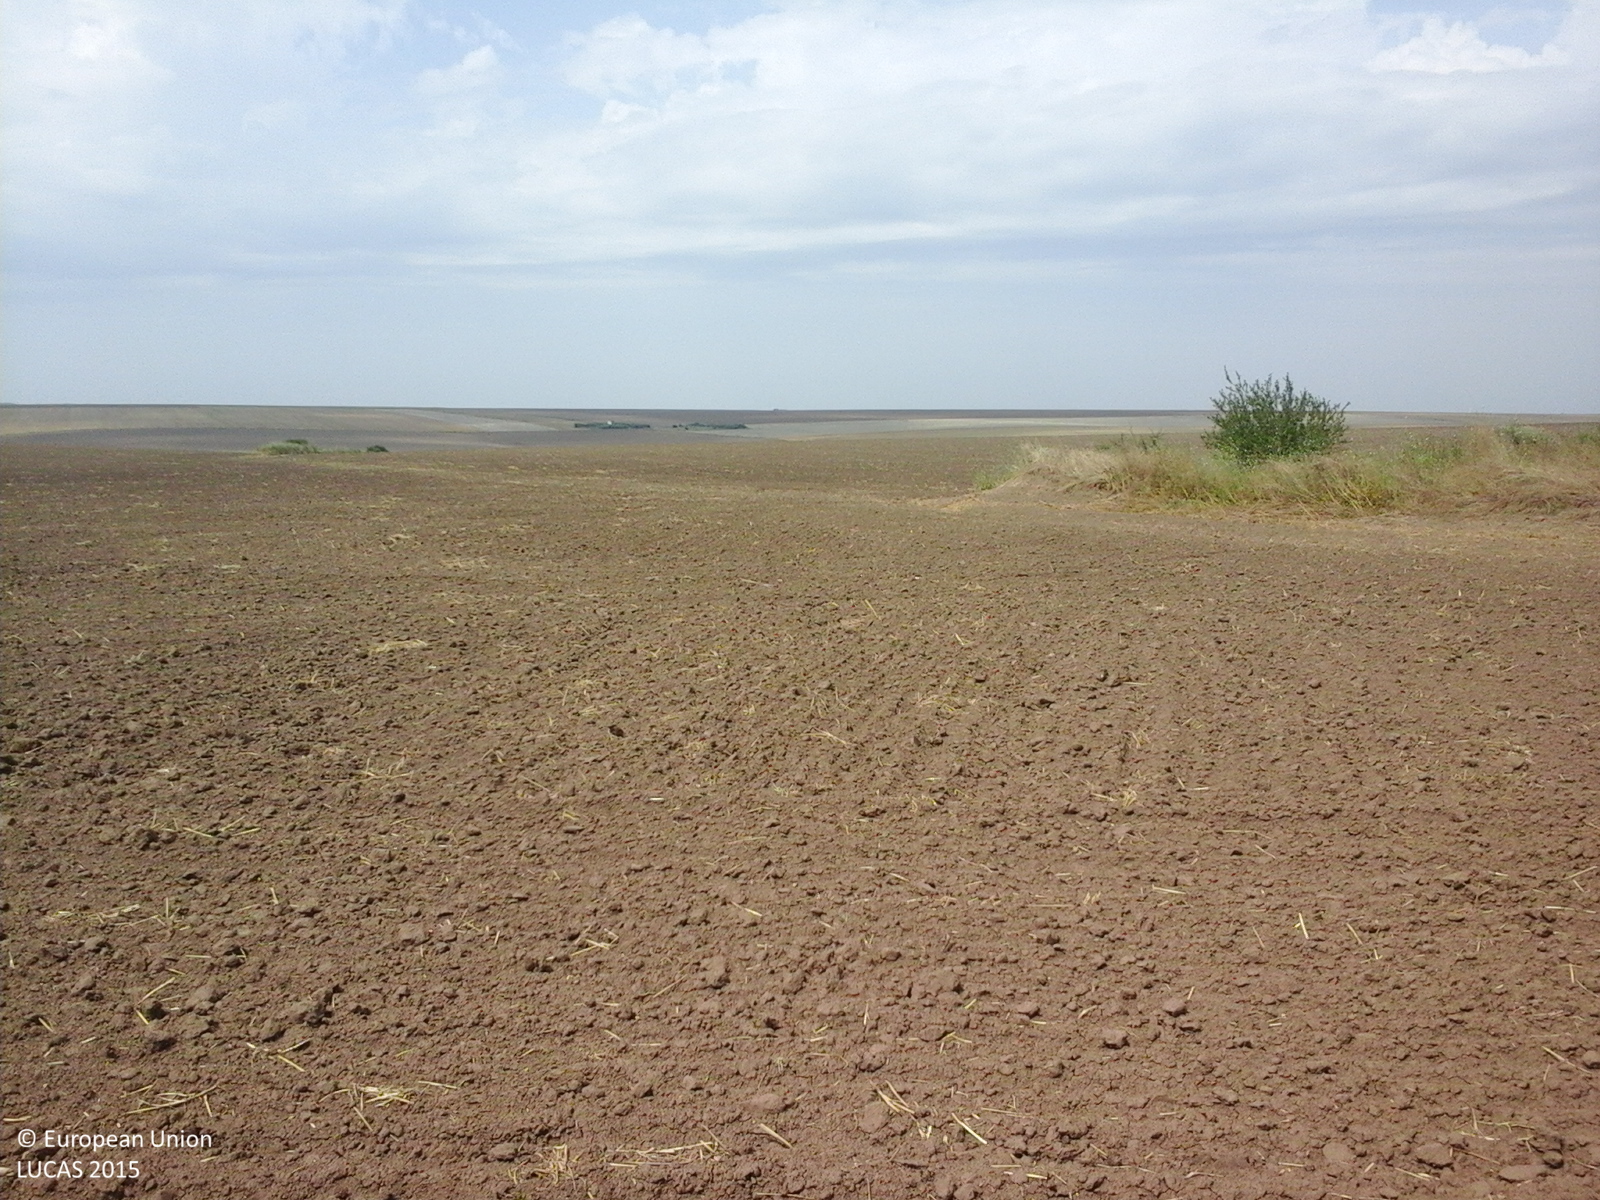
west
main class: Cropland
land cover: Common wheat
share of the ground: < 10 %
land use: Agriculture (excluding fallow land and kitchen gardens)
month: August
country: RO
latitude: 43.8575
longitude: 28.0546
